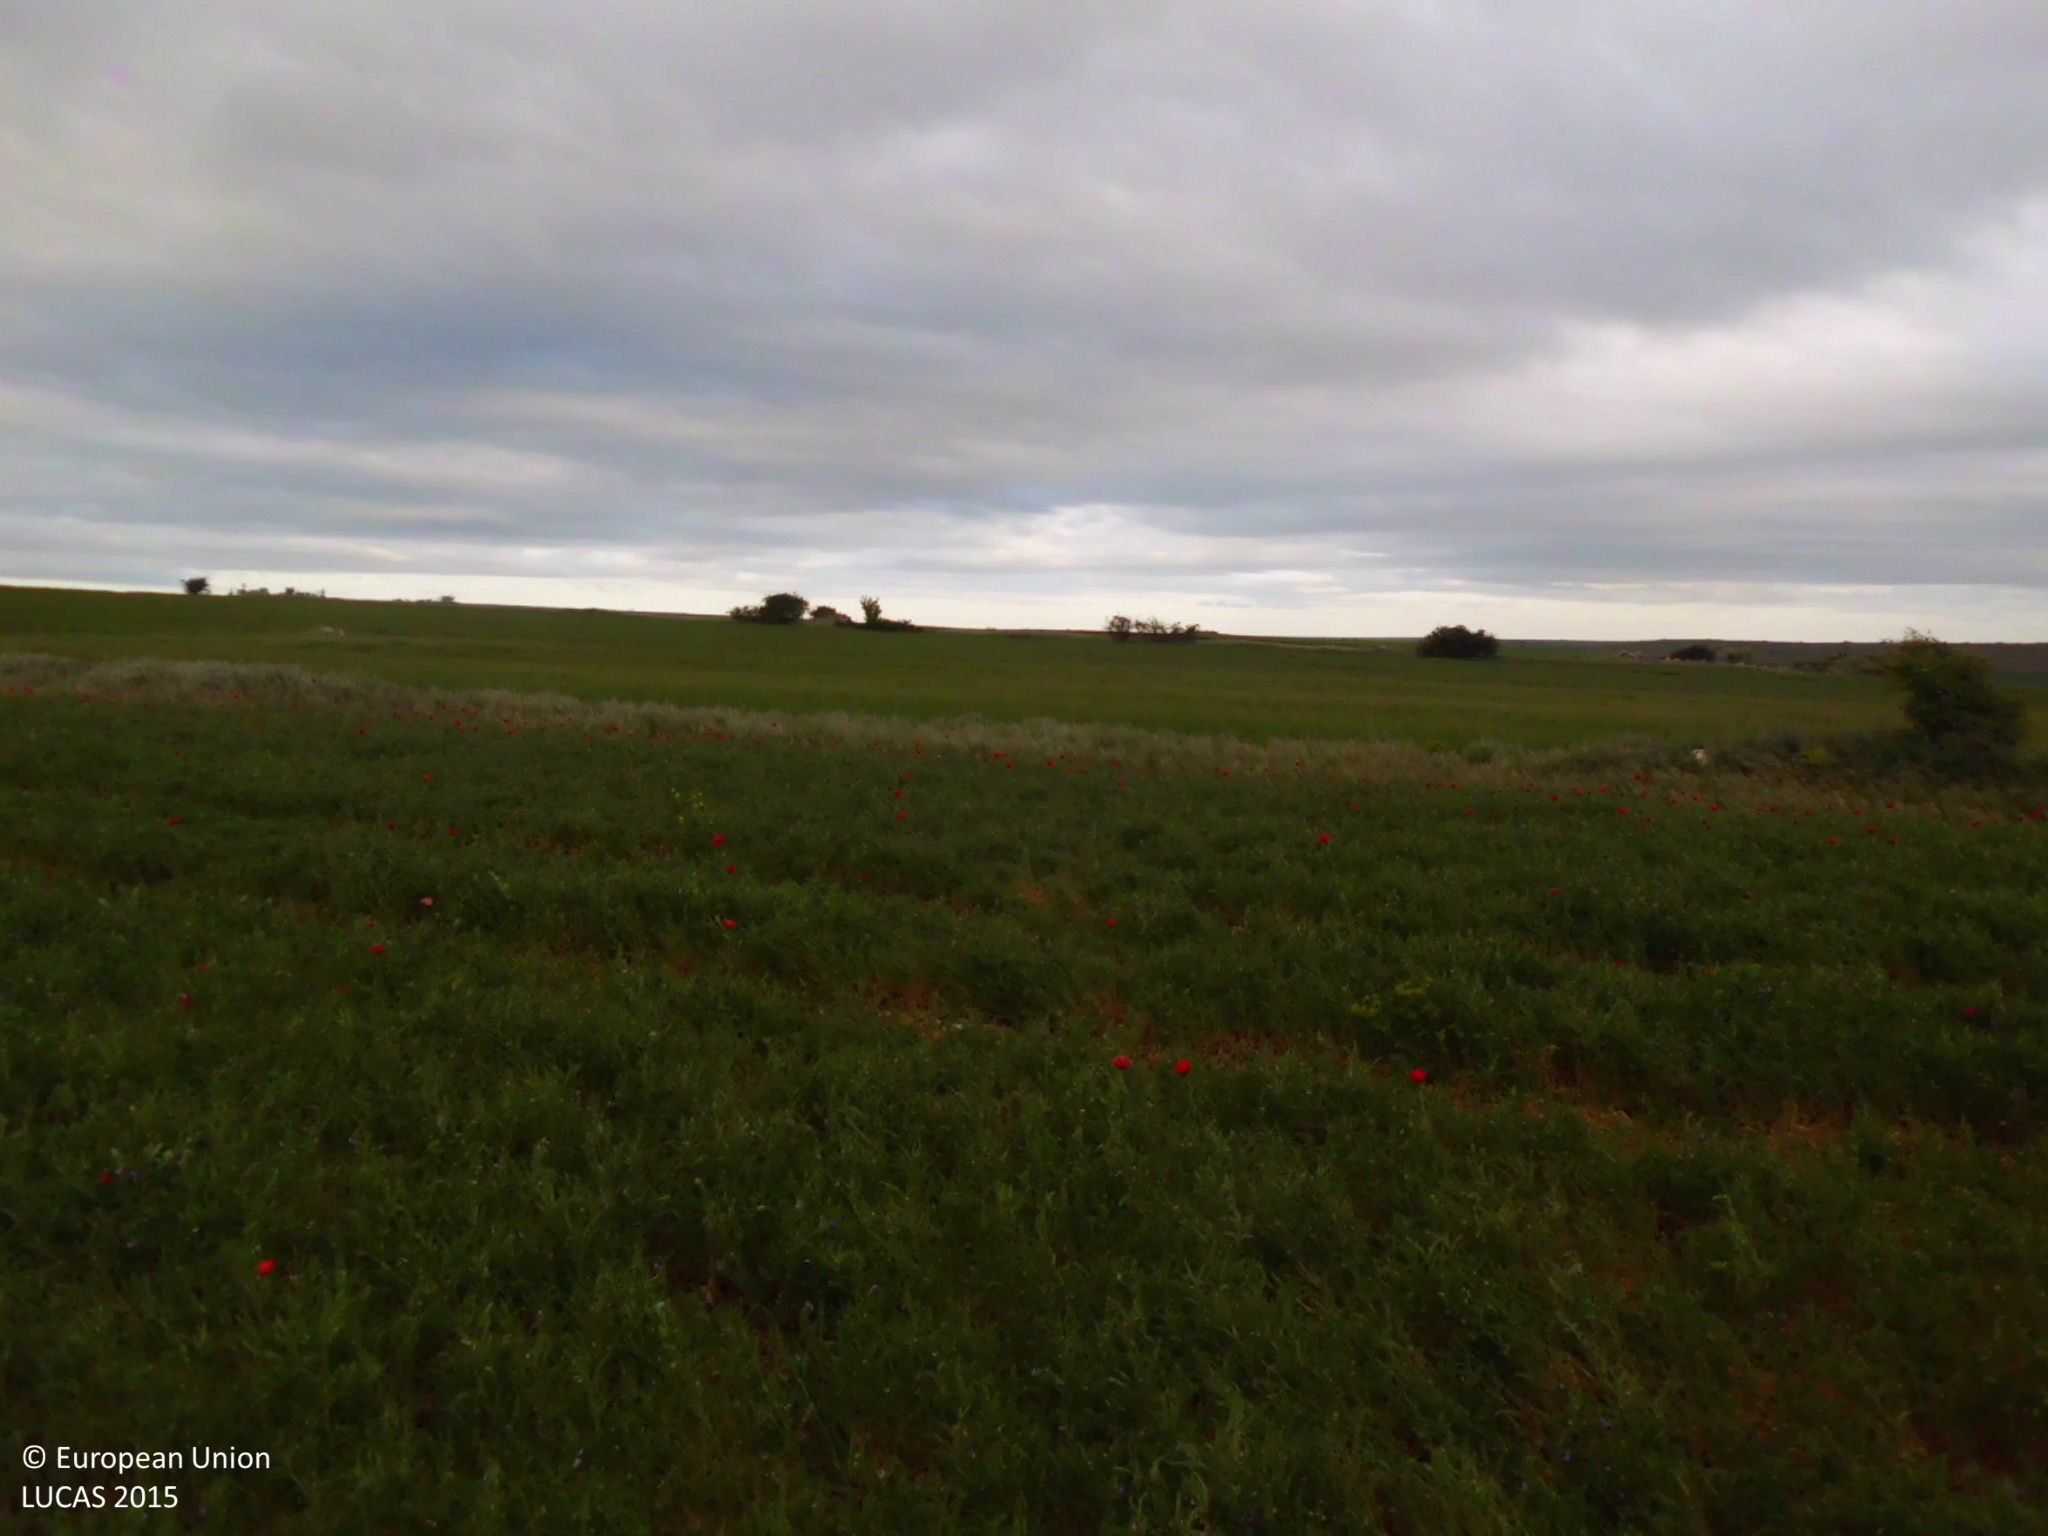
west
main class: Cropland
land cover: Dry pulses
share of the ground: > 75 %
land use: Agriculture (excluding fallow land and kitchen gardens)
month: May
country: ES
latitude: 42.3846
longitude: -3.7752
